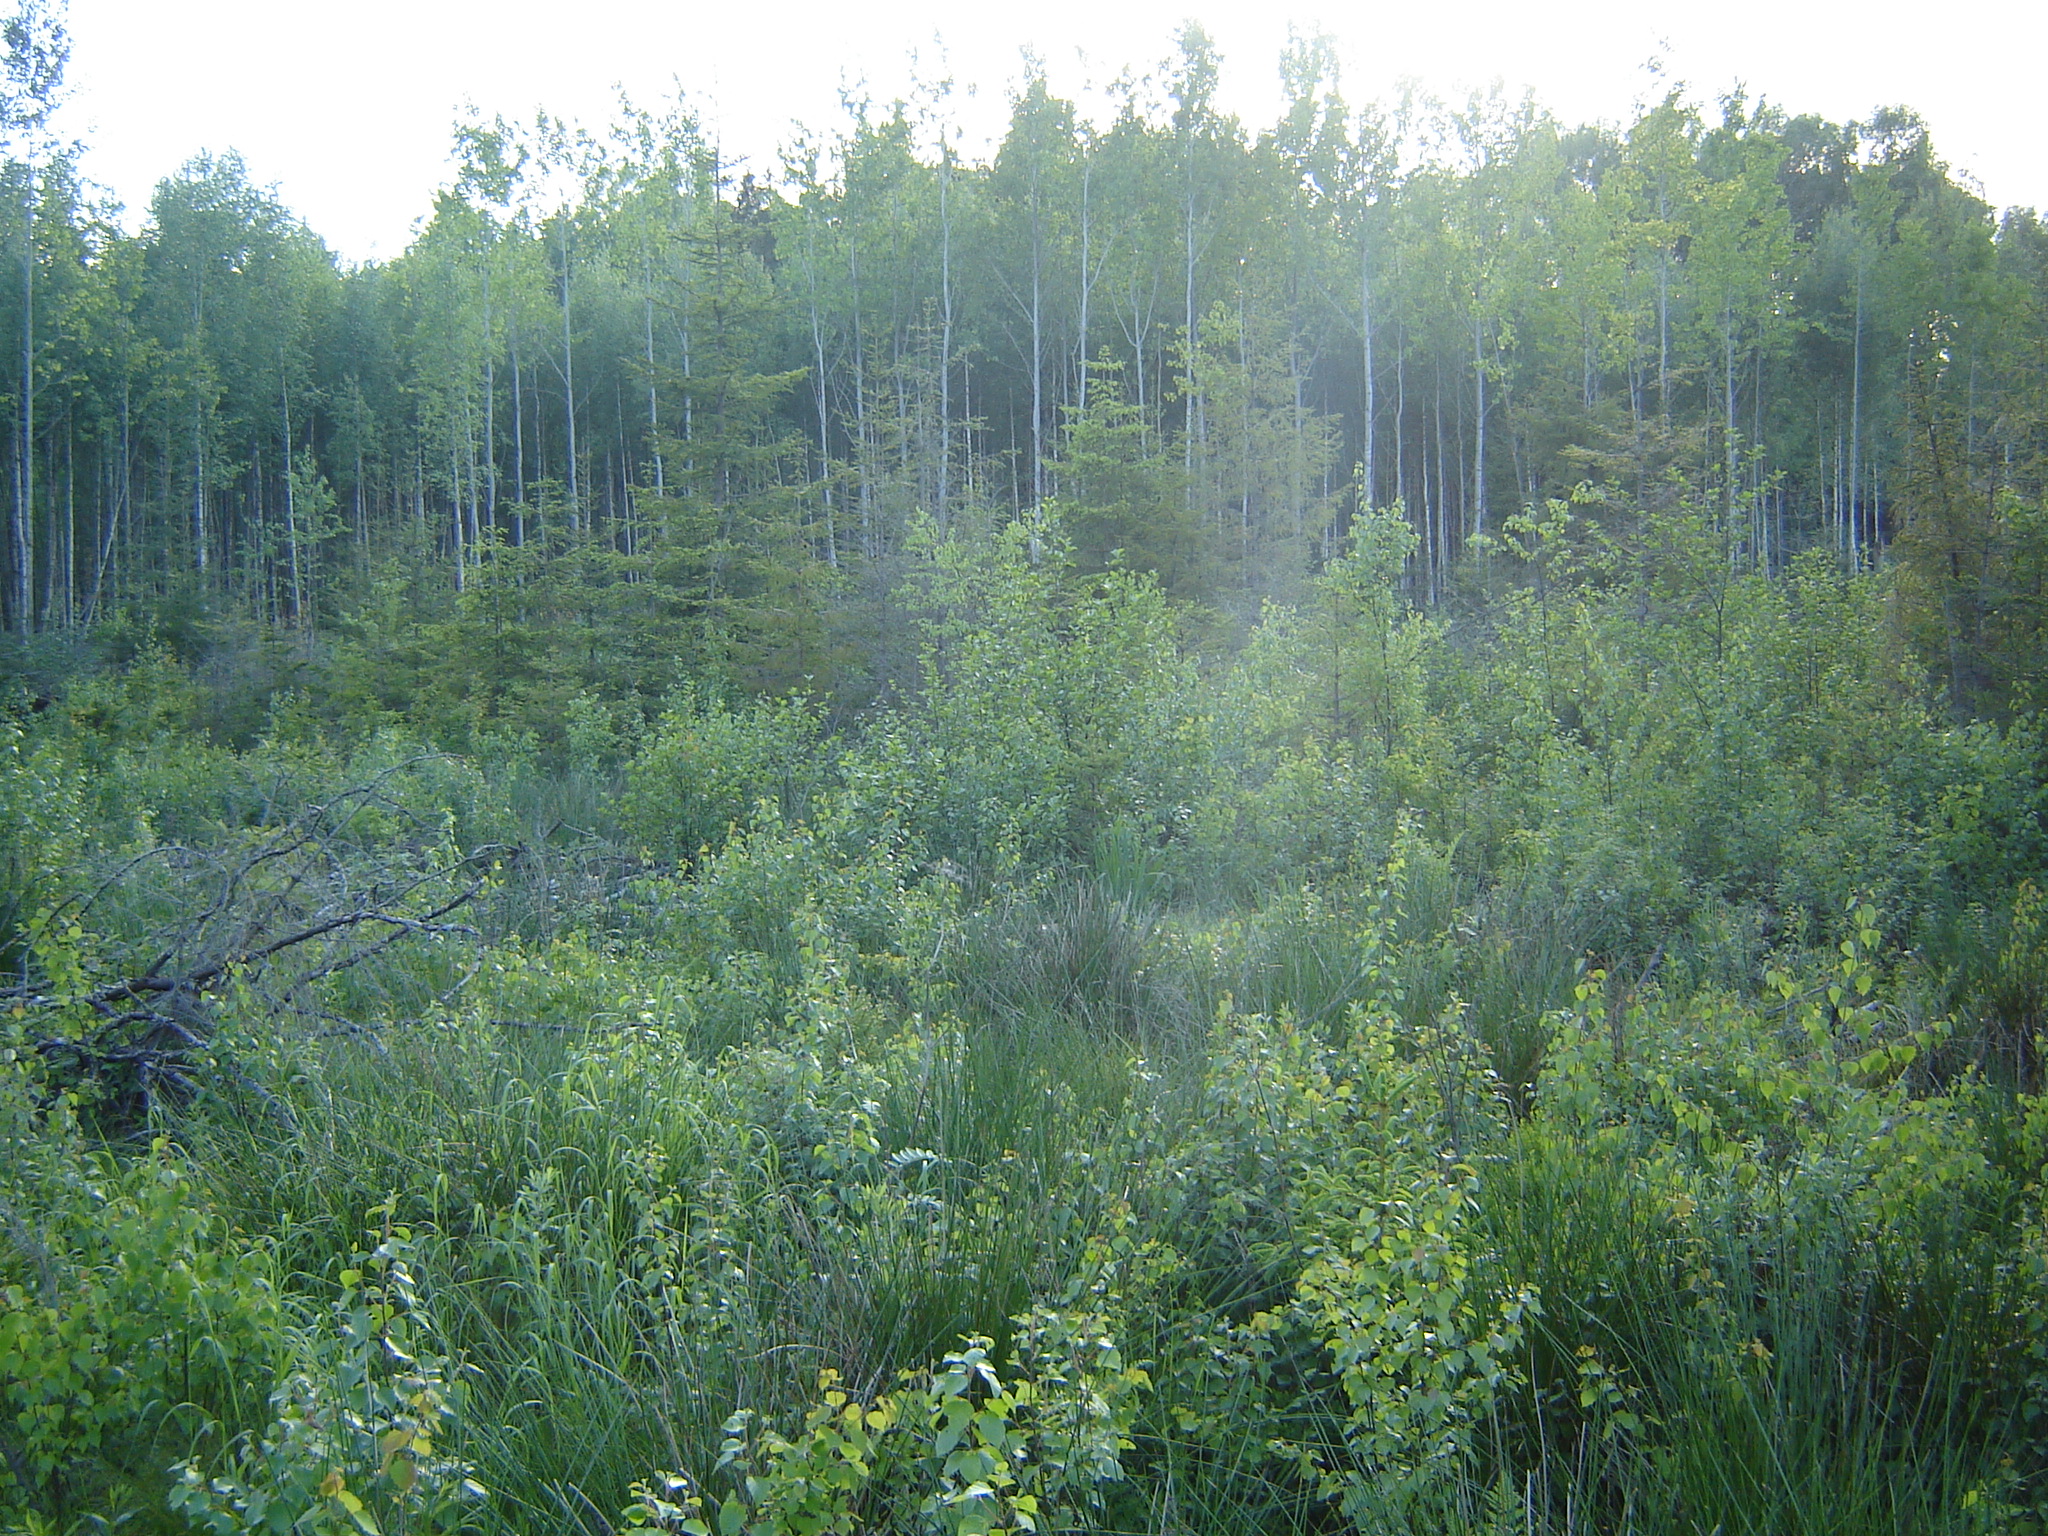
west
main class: Woodland
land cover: Spruce dominated mixed woodland
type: hemiboreal forest and nemoral coniferous forest and mixed broadleaved-coniferous forest
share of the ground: 50 - 75 %
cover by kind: broadleaved forest trees 40 %, coniferous forest trees 30 %, herbaceous plants 30 %
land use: Forestry
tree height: < 5 m
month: May
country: LT
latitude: 55.7583
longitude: 25.1413
